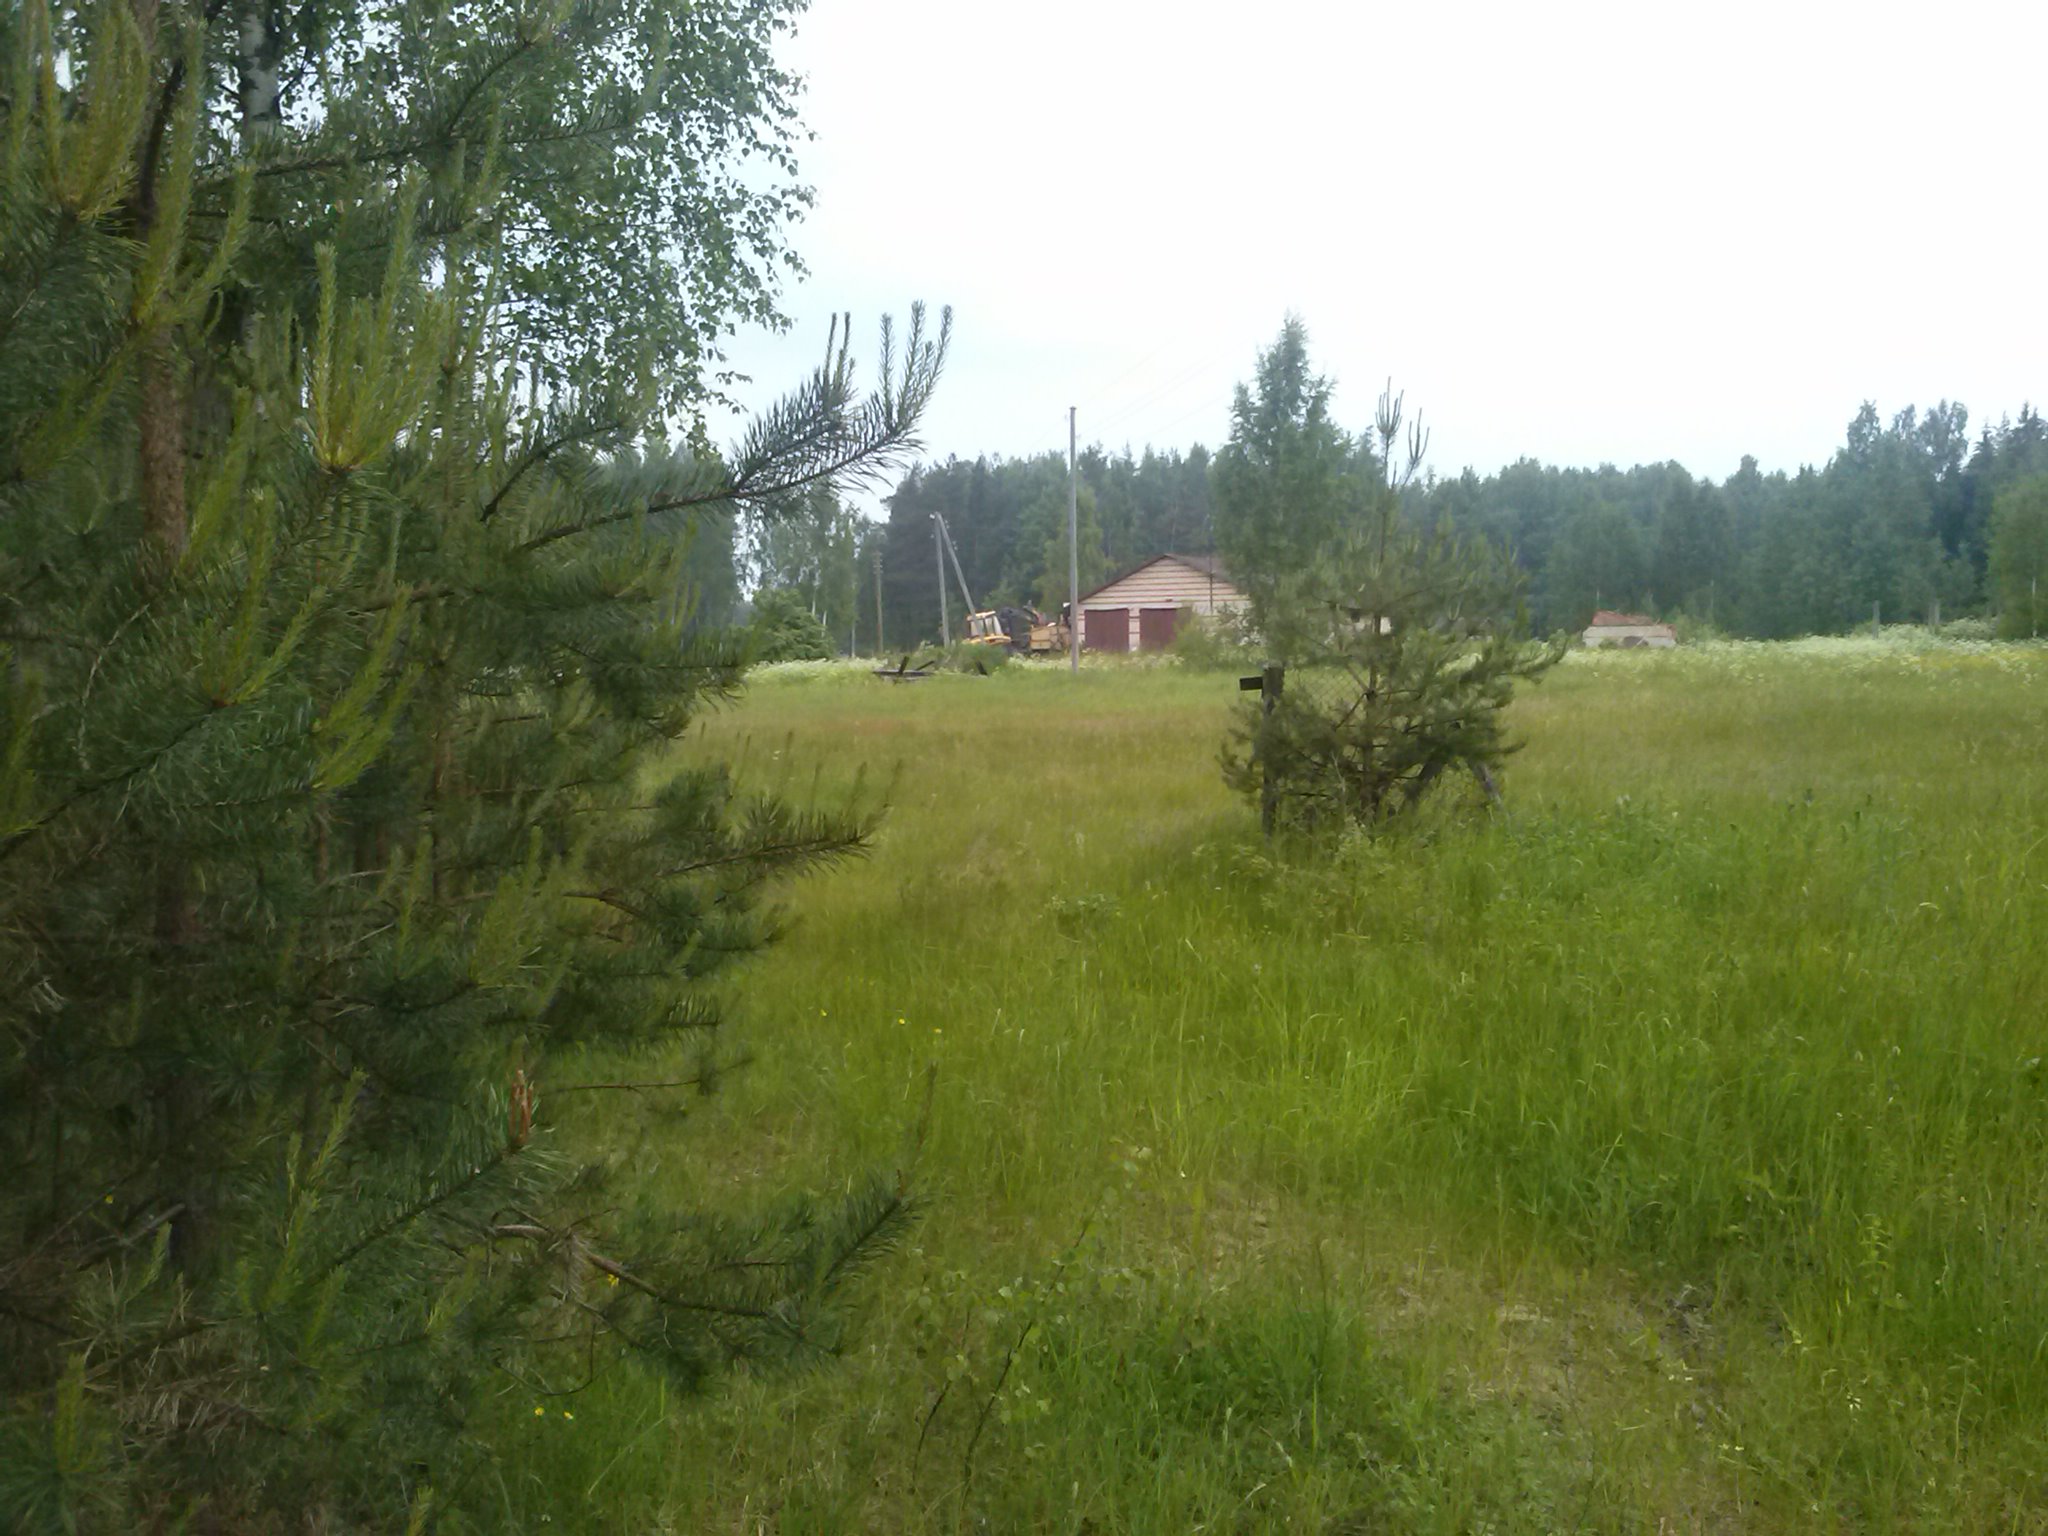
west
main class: Woodland
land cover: Broadleaved woodland
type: non-riverine alder, birch or aspen forest
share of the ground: 50 - 75 %
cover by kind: broadleaved forest trees 50 %, herbaceous plants 40 %, coniferous forest trees 5 %, shrubs 5 %
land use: Abandoned areas
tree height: > 5 m
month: June
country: LV
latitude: 56.9127
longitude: 27.1993
